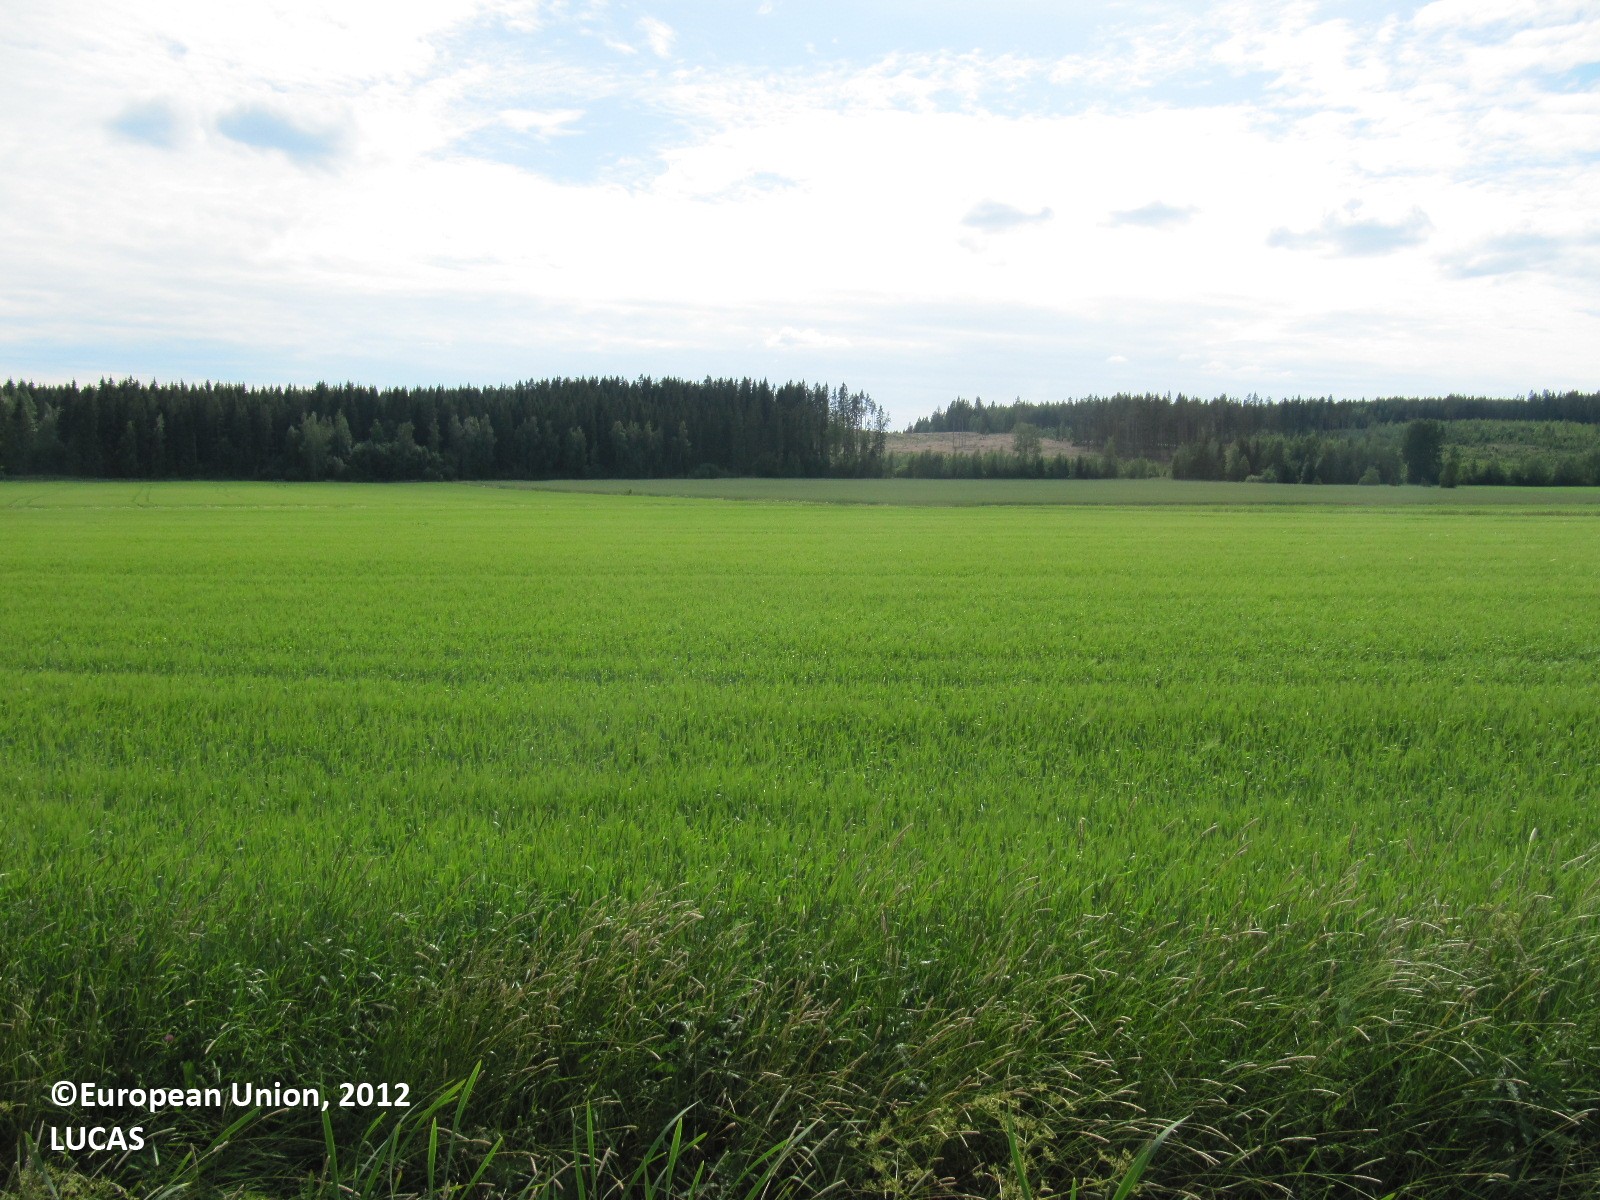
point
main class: Cropland
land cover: Barley
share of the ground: > 75 %
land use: Agriculture (excluding fallow land and kitchen gardens)
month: July
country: FI
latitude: 60.8915
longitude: 23.4057
